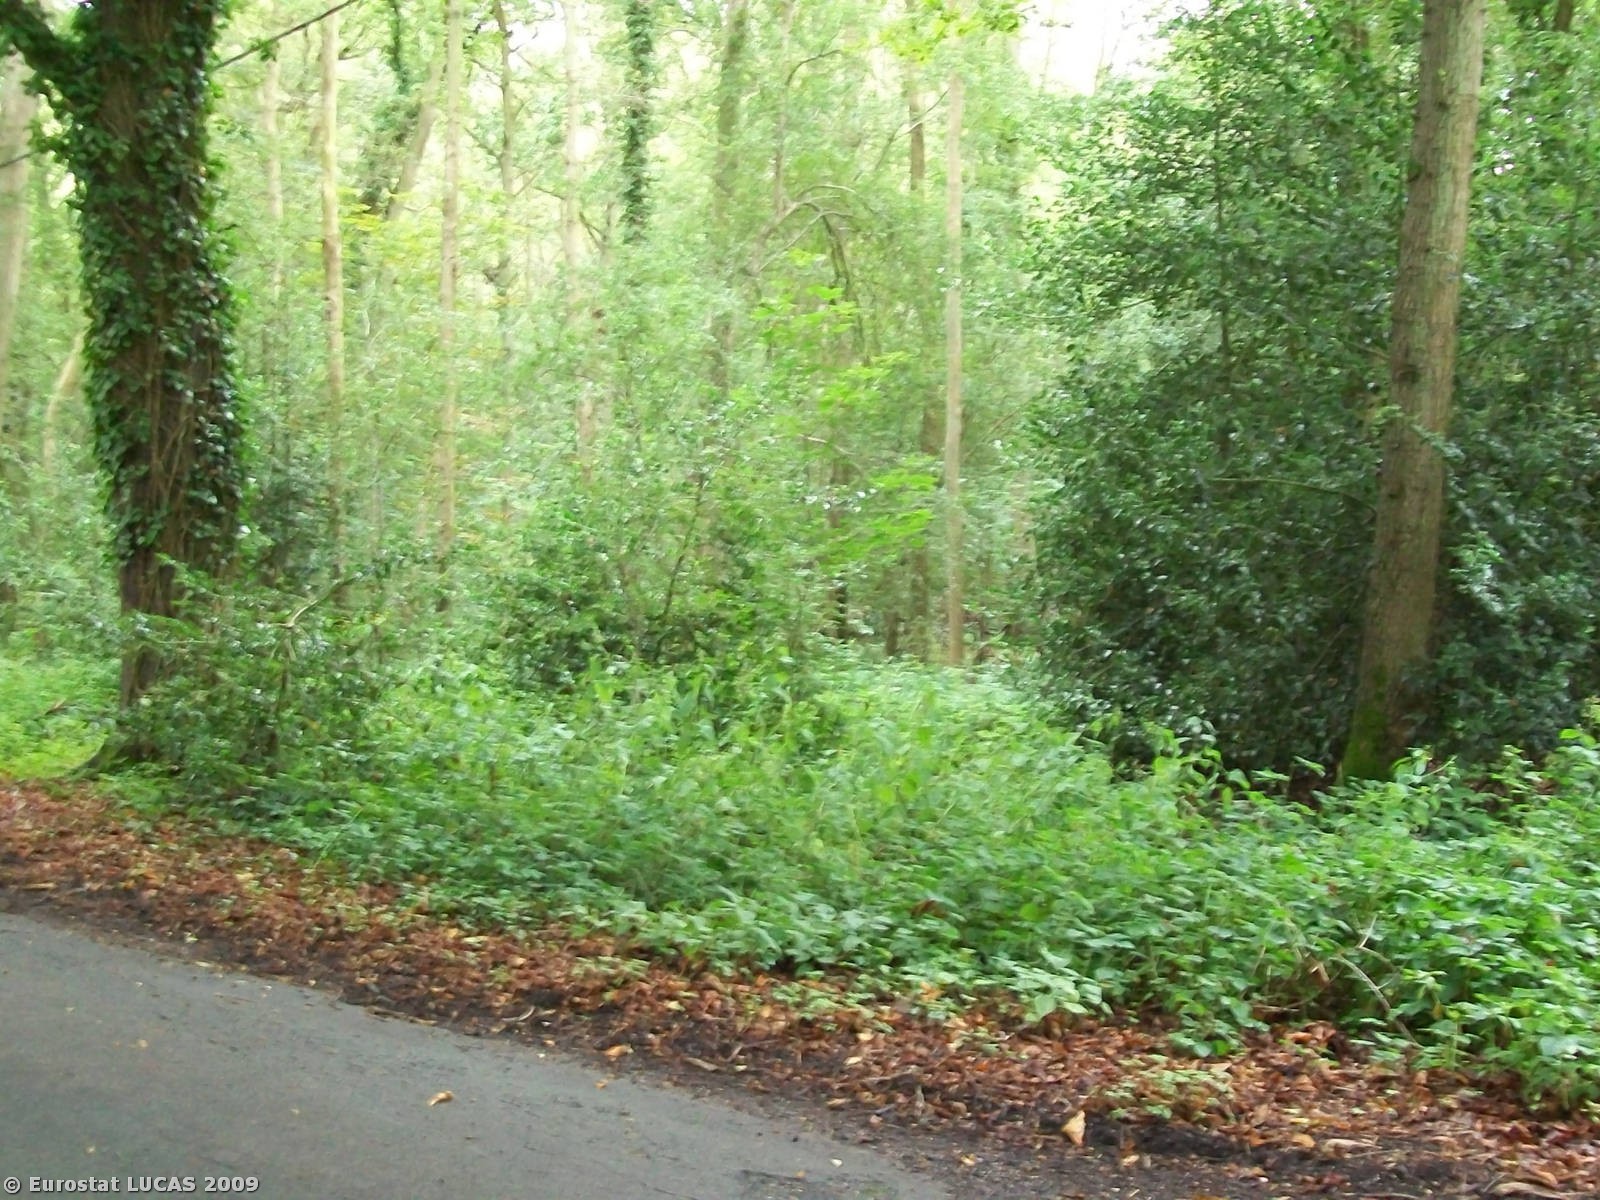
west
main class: Woodland
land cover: Broadleaved woodland
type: mesophytic deciduous forest
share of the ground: > 75 %
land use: Unused
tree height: > 5 m
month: August
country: GB
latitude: 51.3890
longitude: -1.0384
